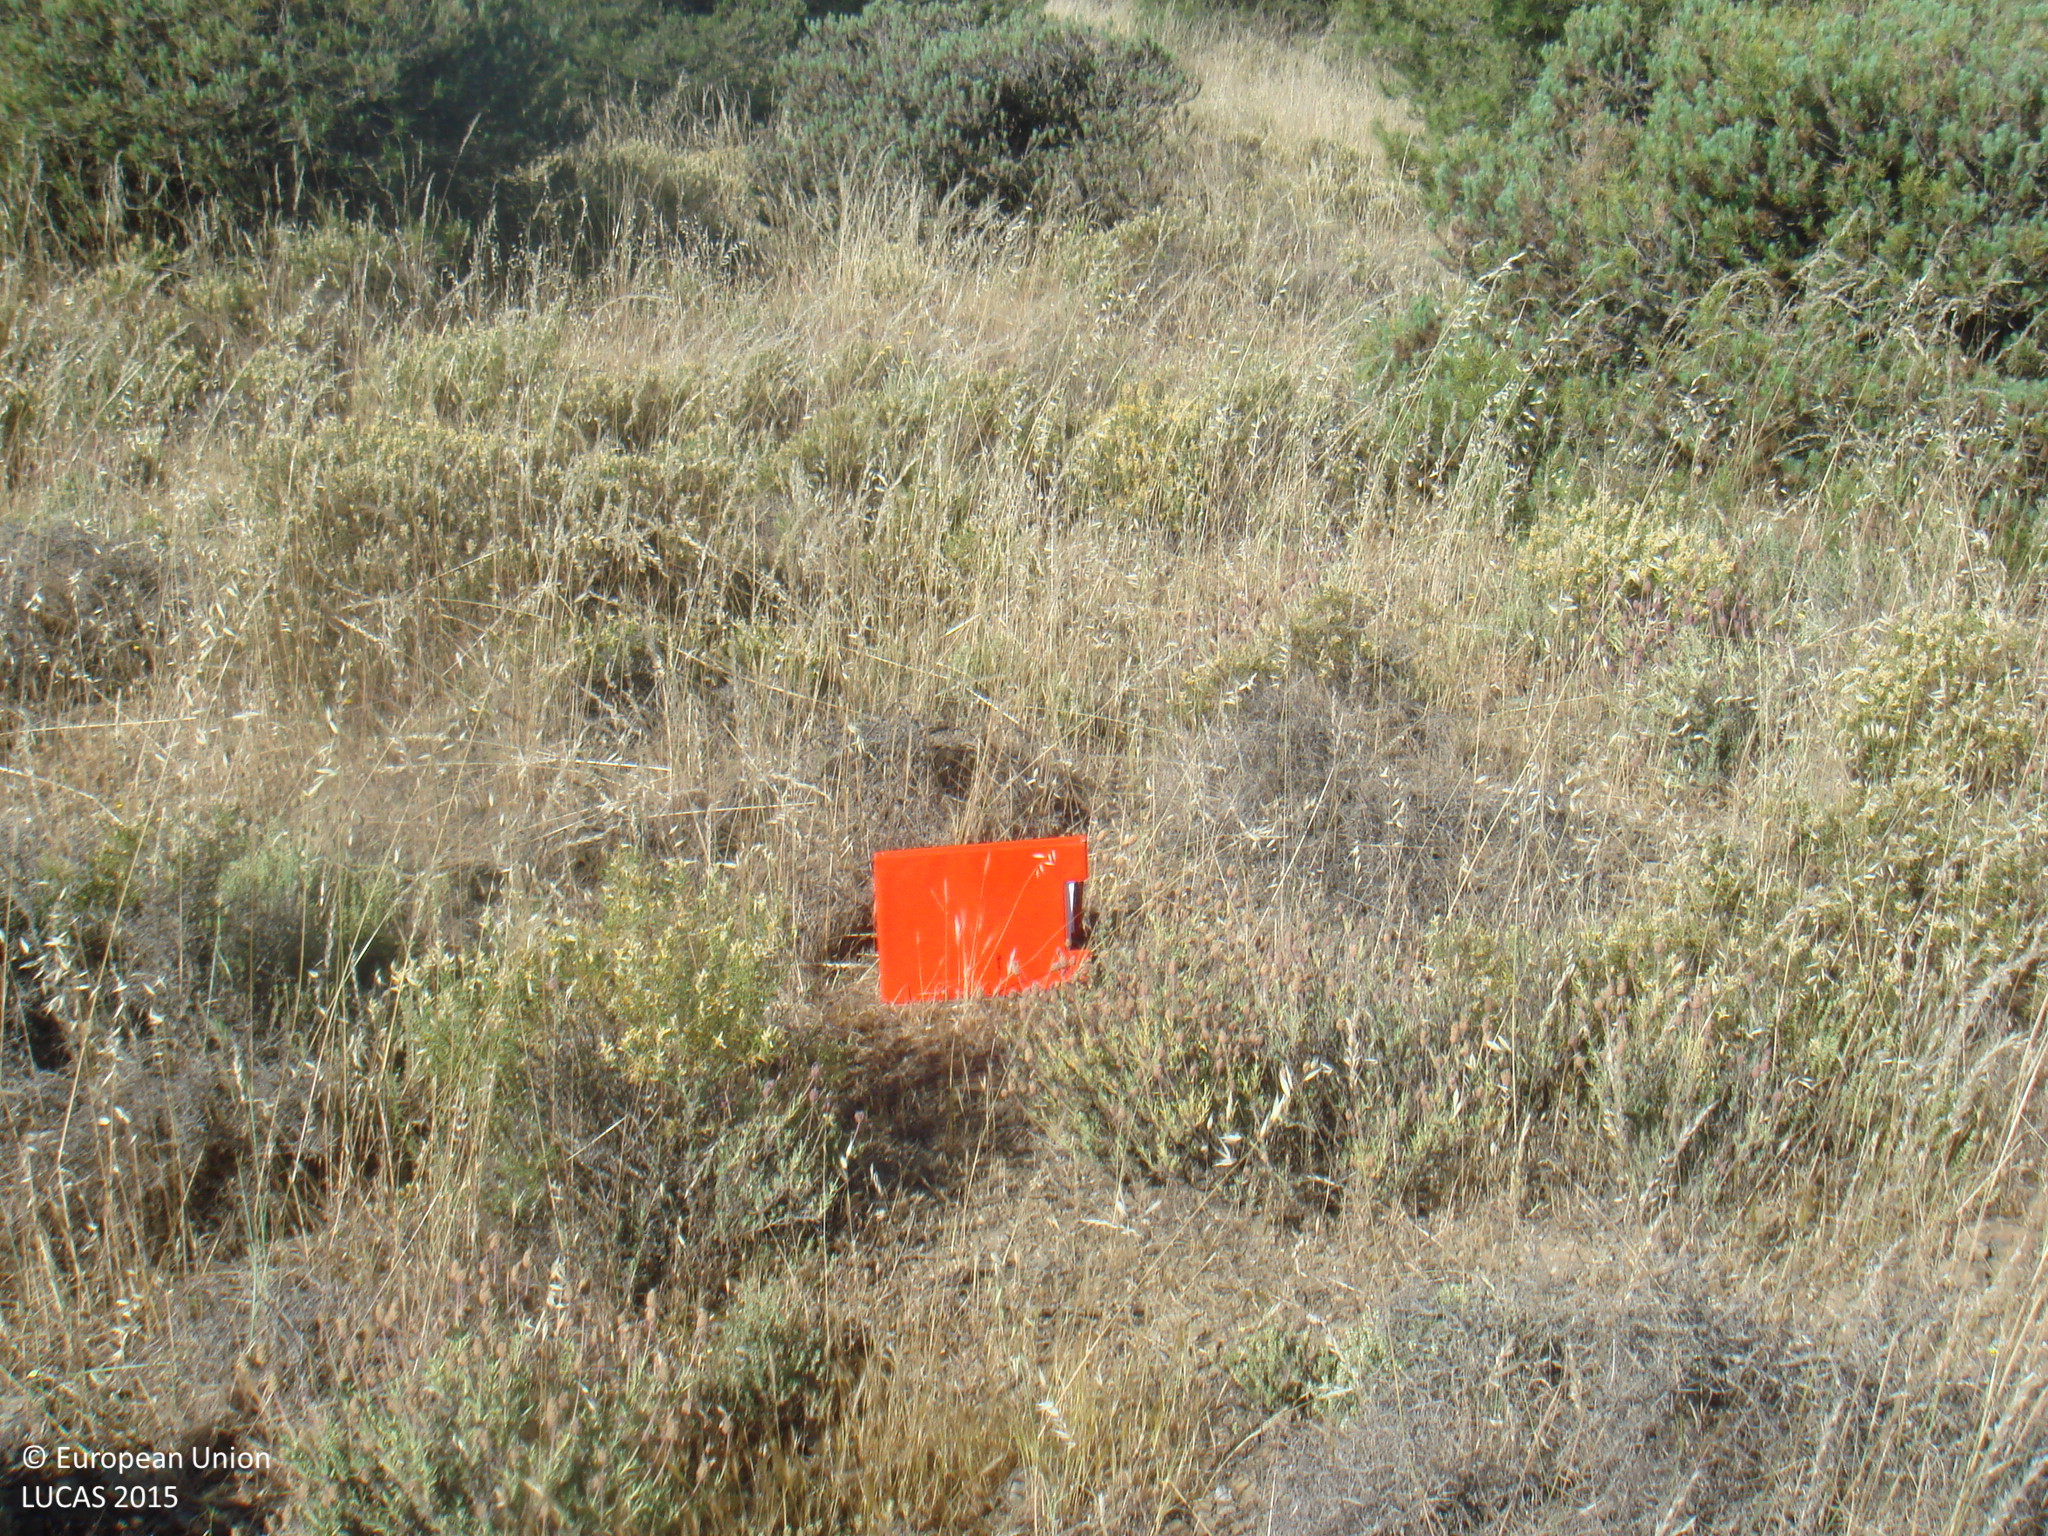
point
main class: Woodland
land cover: Pine dominated coniferous woodland
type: coniferous forest of the mediterranean region
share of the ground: 10 - 25 %
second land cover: Shrubland without tree cover
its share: 10 - 25 %
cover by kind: herbaceous plants 65 %, coniferous forest trees 25 %, shrubs 10 %
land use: Forestry
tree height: < 5 m
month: May
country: ES
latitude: 38.6045
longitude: -5.1548
